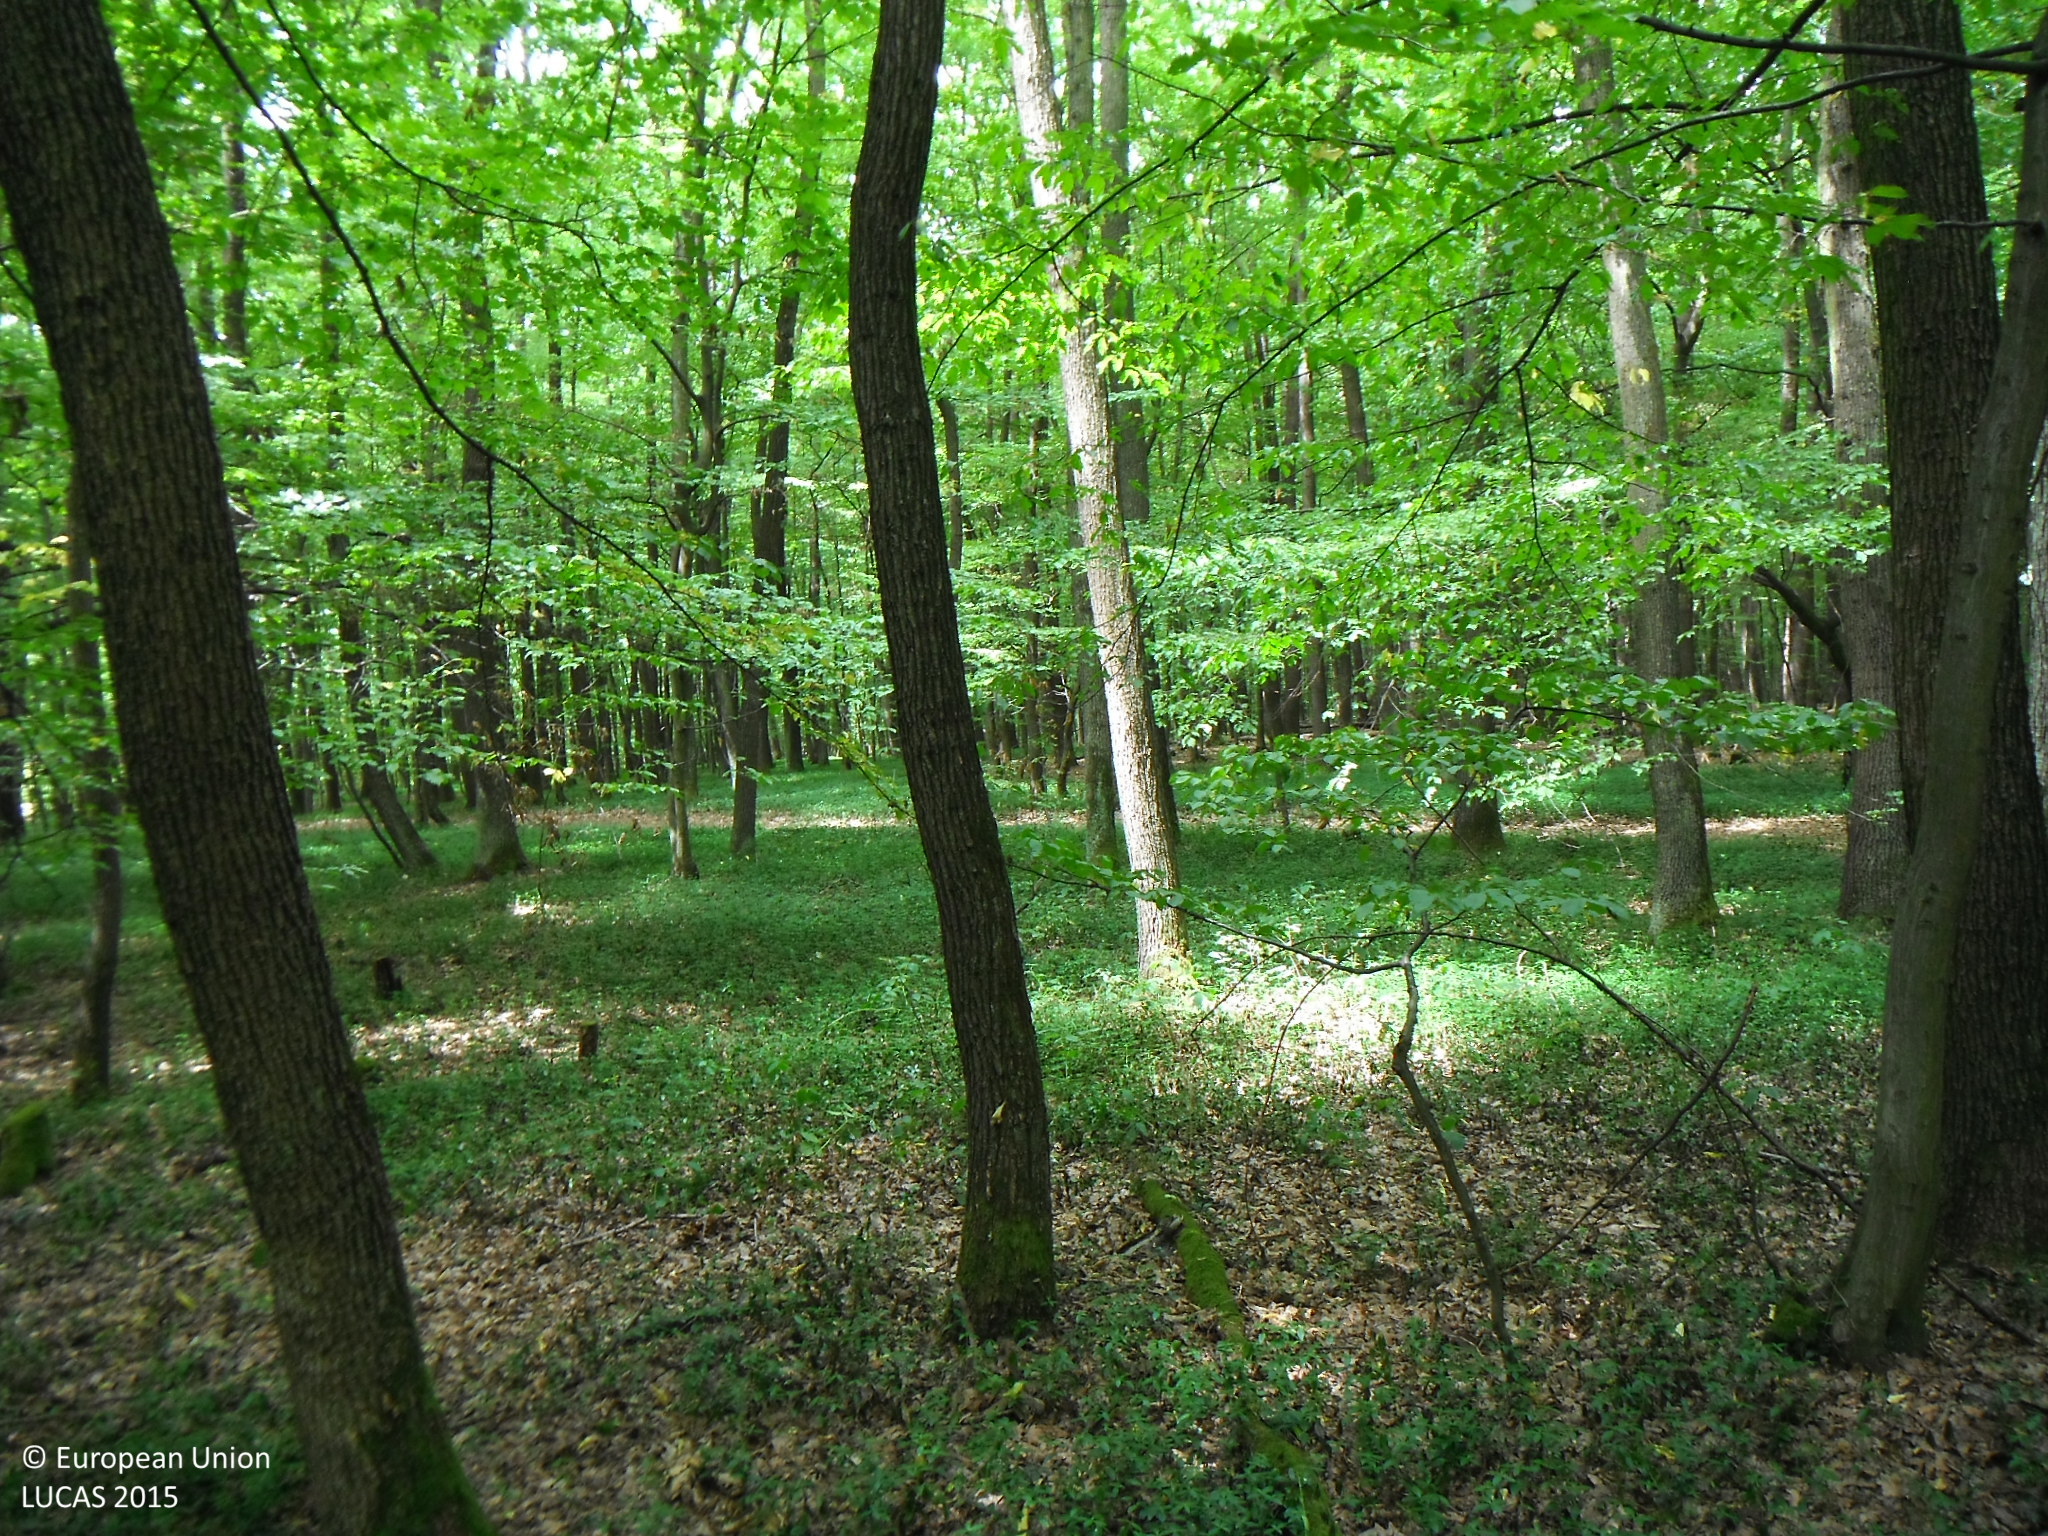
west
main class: Woodland
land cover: Broadleaved woodland
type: acidophilous oak and oak-birch forest
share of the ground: > 75 %
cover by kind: broadleaved forest trees 100 %
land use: Forestry
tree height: > 5 m
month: July
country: SK
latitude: 48.6934
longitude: 21.3075
